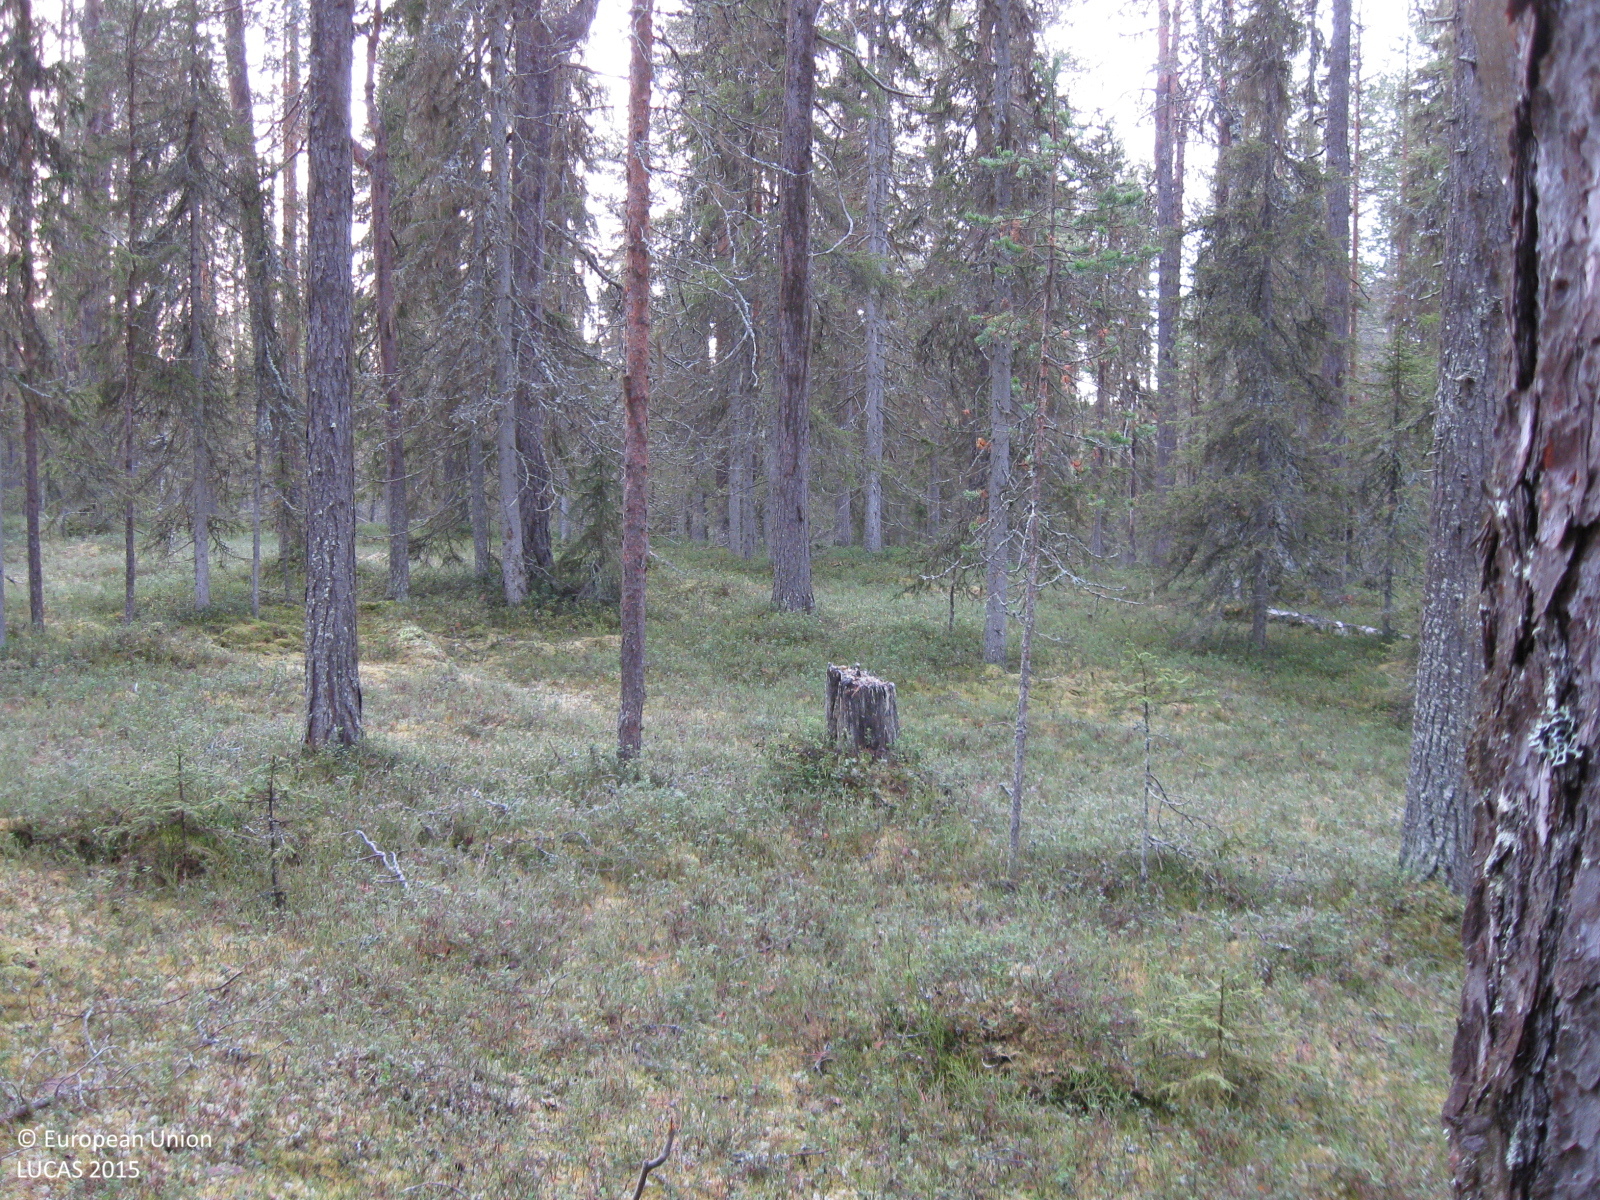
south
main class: Woodland
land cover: Pine dominated coniferous woodland
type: boreal forest
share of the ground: 50 - 75 %
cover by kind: coniferous forest trees 70 %, shrubs 15 %, lichens and mosses 10 %, herbaceous plants 5 %
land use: Forestry
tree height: > 5 m
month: October
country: SE
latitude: 66.4134
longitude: 20.9564
